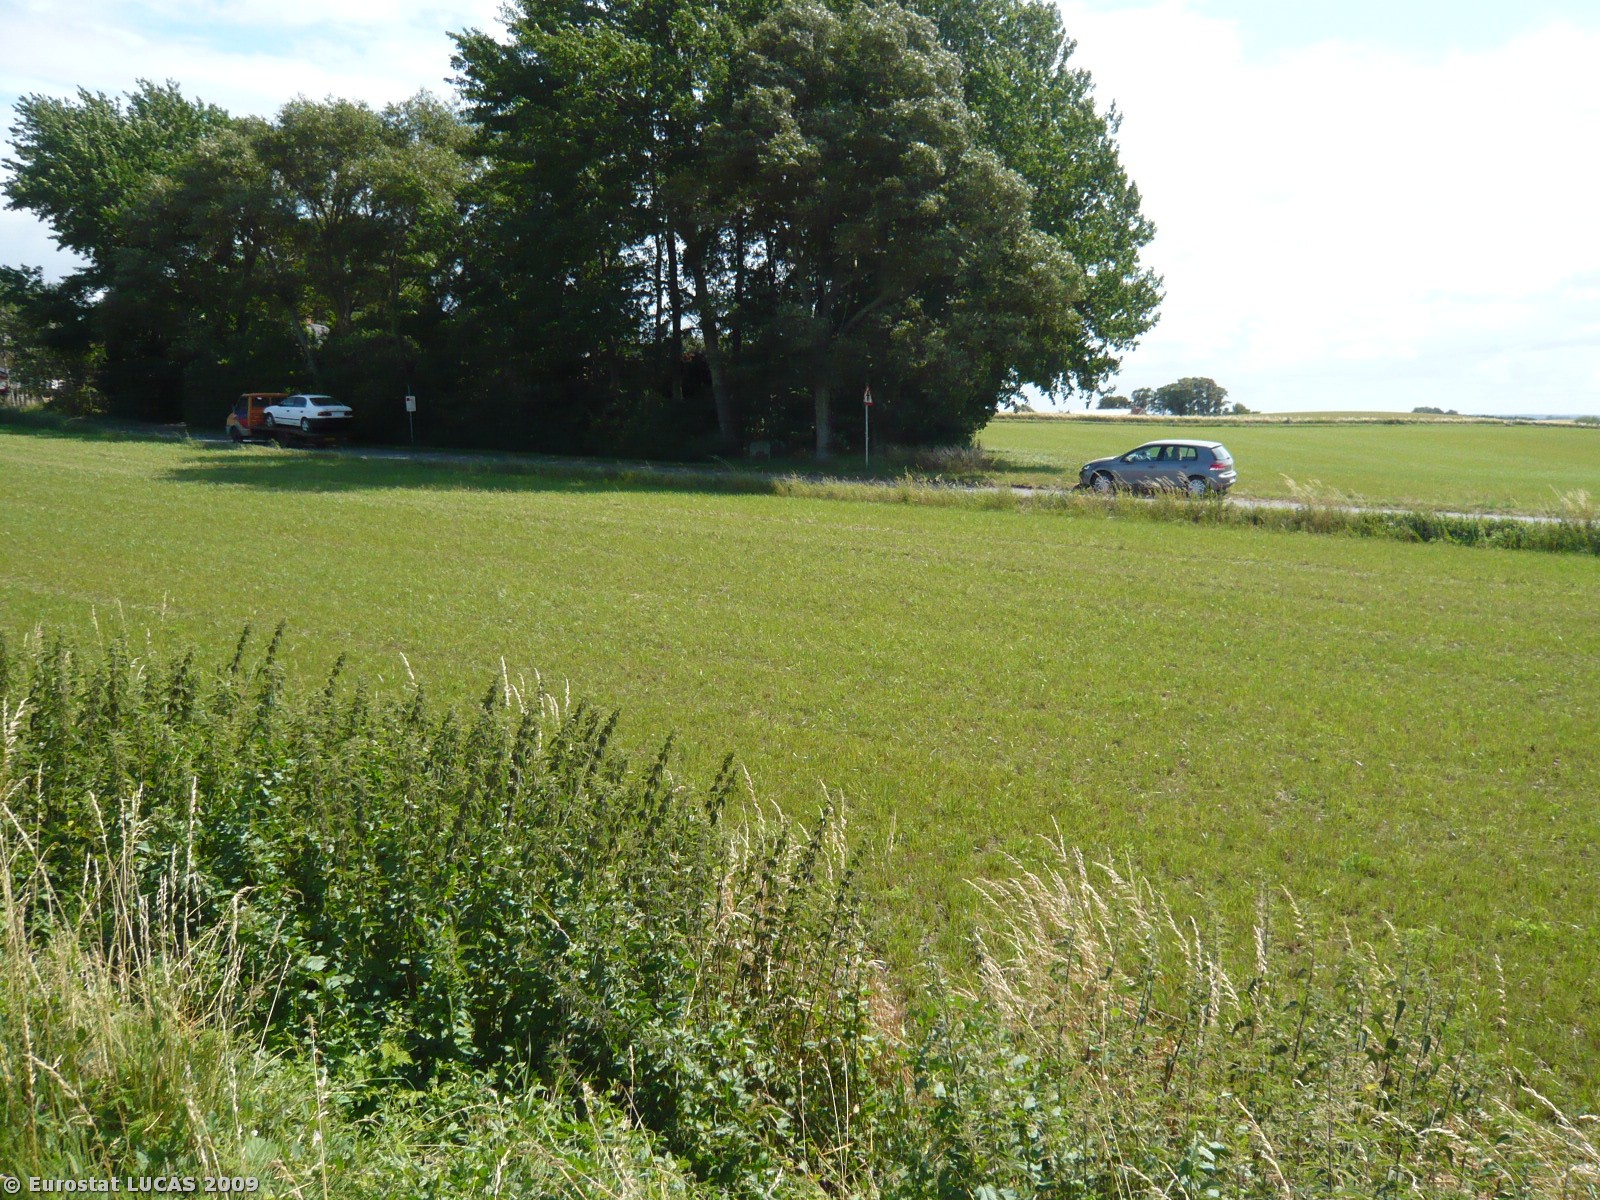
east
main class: Cropland
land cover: Barley
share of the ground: > 75 %
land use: Agriculture (excluding fallow land and kitchen gardens)
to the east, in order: Barley; Artificial constructions; Grassland without tree/shrub cover; Paved roads, cycling and walking lanes; Artificial constructions in urban areas; Fences; Grassland without tree/shrub cover
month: July
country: DK
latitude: 55.4796
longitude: 11.3437
